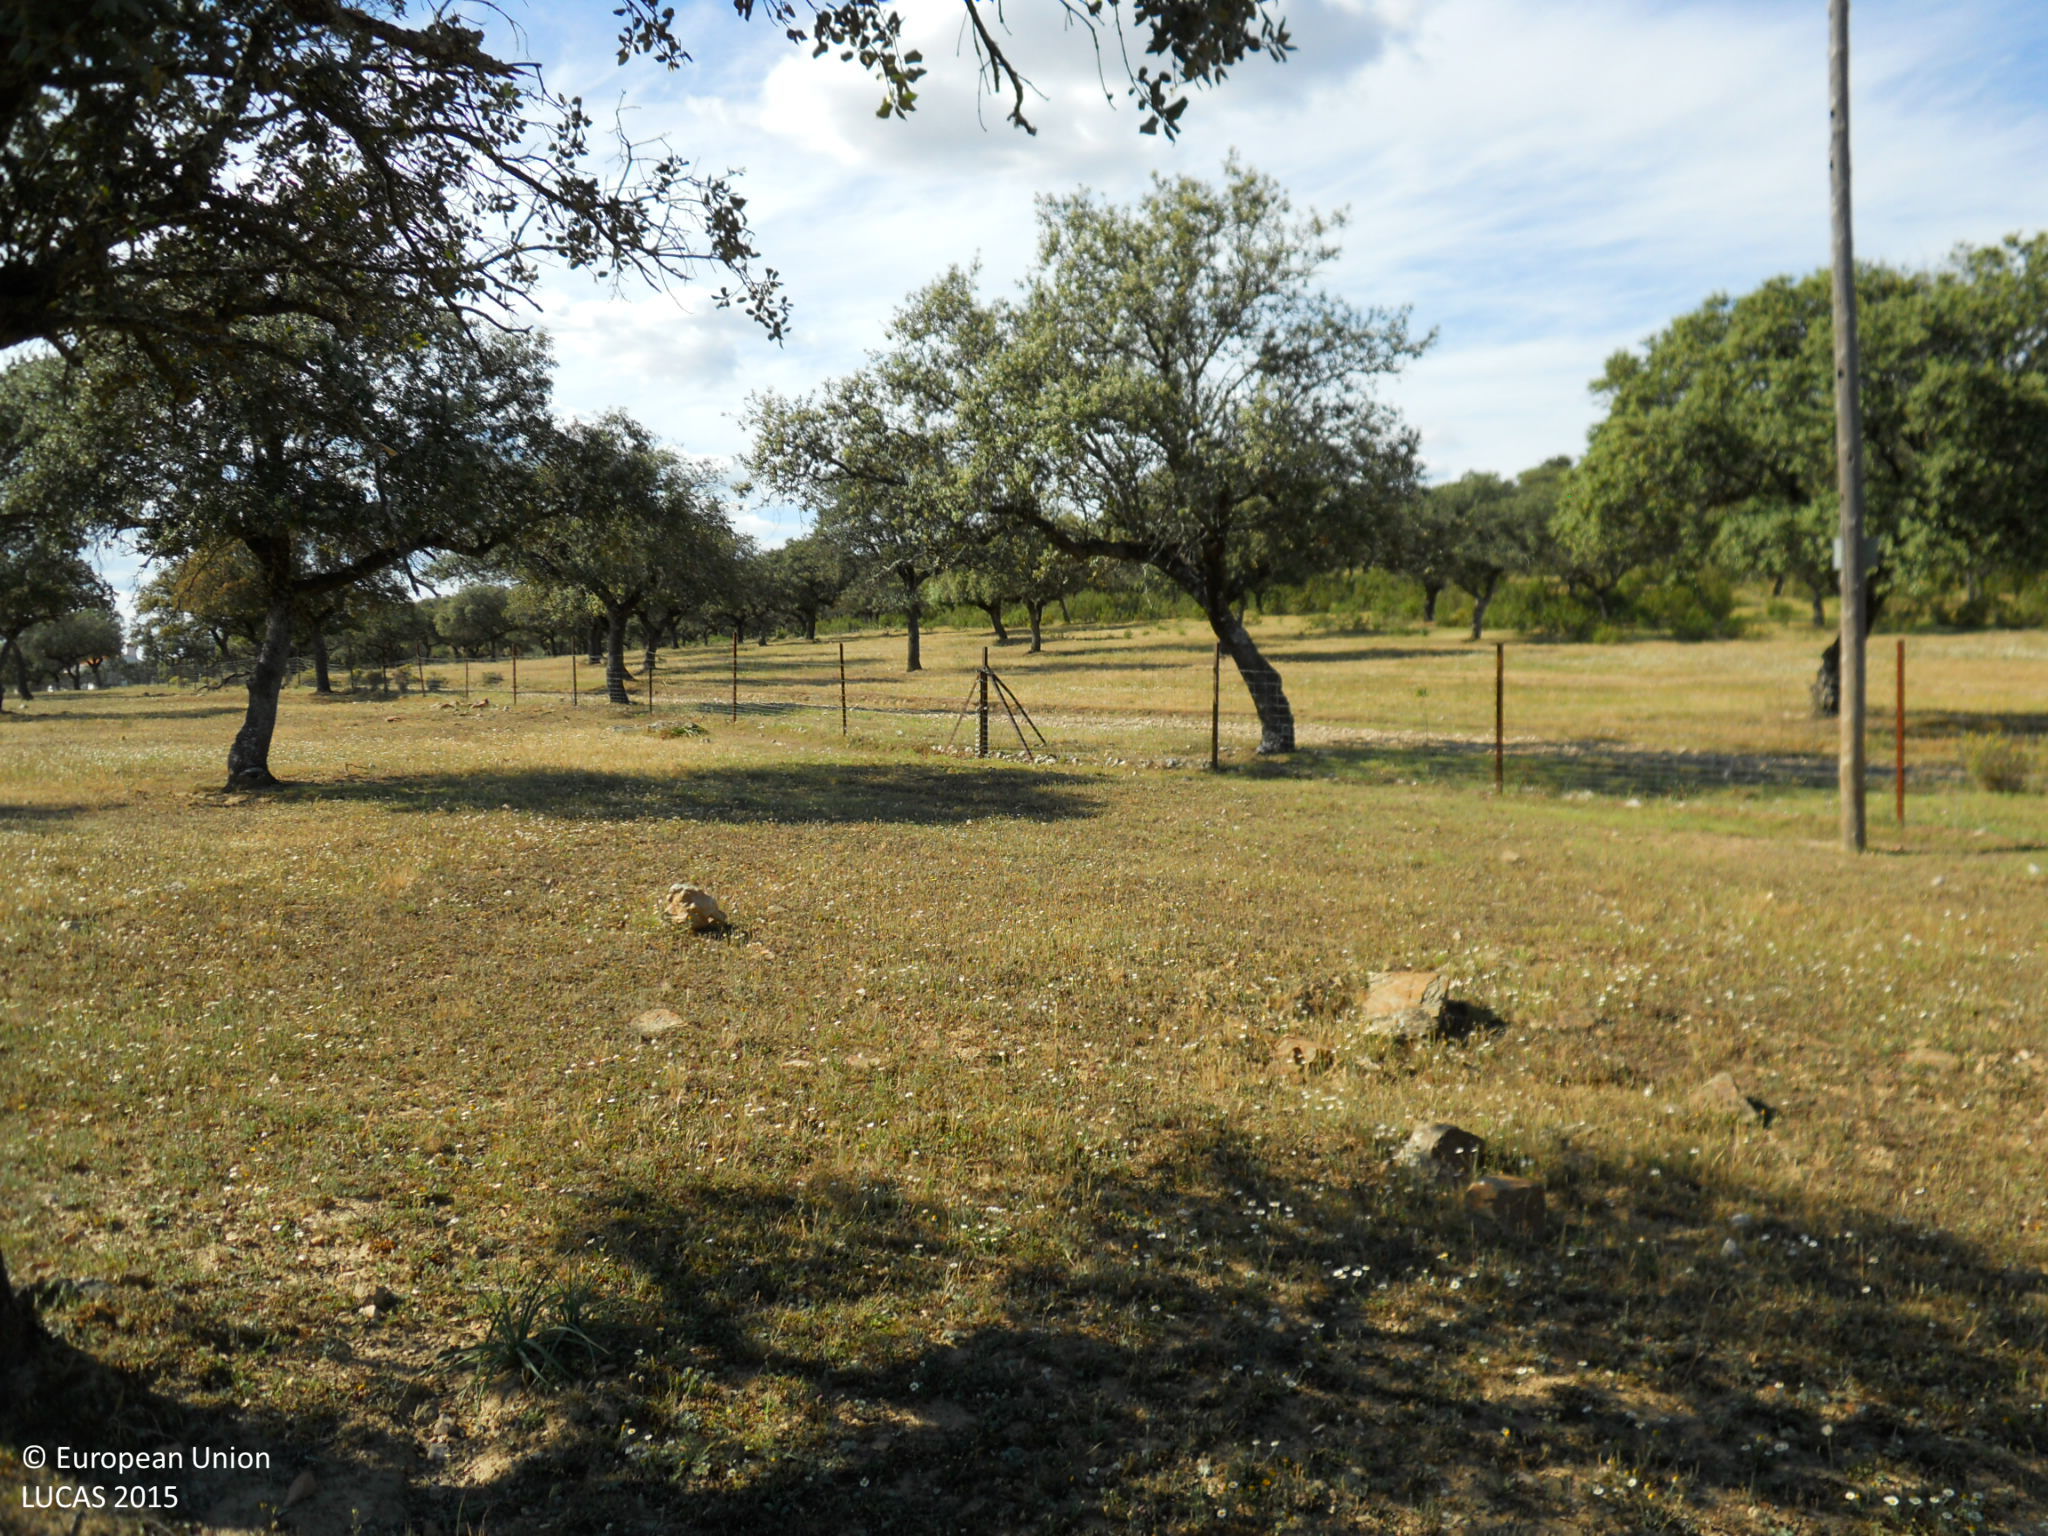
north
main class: Woodland
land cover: Broadleaved woodland
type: broadleaved evergreen forest
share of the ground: 25 - 50 %
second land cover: Grassland without tree/shrub cover
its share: > 75 %
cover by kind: herbaceous plants 65 %, broadleaved forest trees 35 %
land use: Forestry
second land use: Agriculture (excluding fallow land and kitchen gardens)
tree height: > 5 m
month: April
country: ES
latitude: 39.3579
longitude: -6.9167
